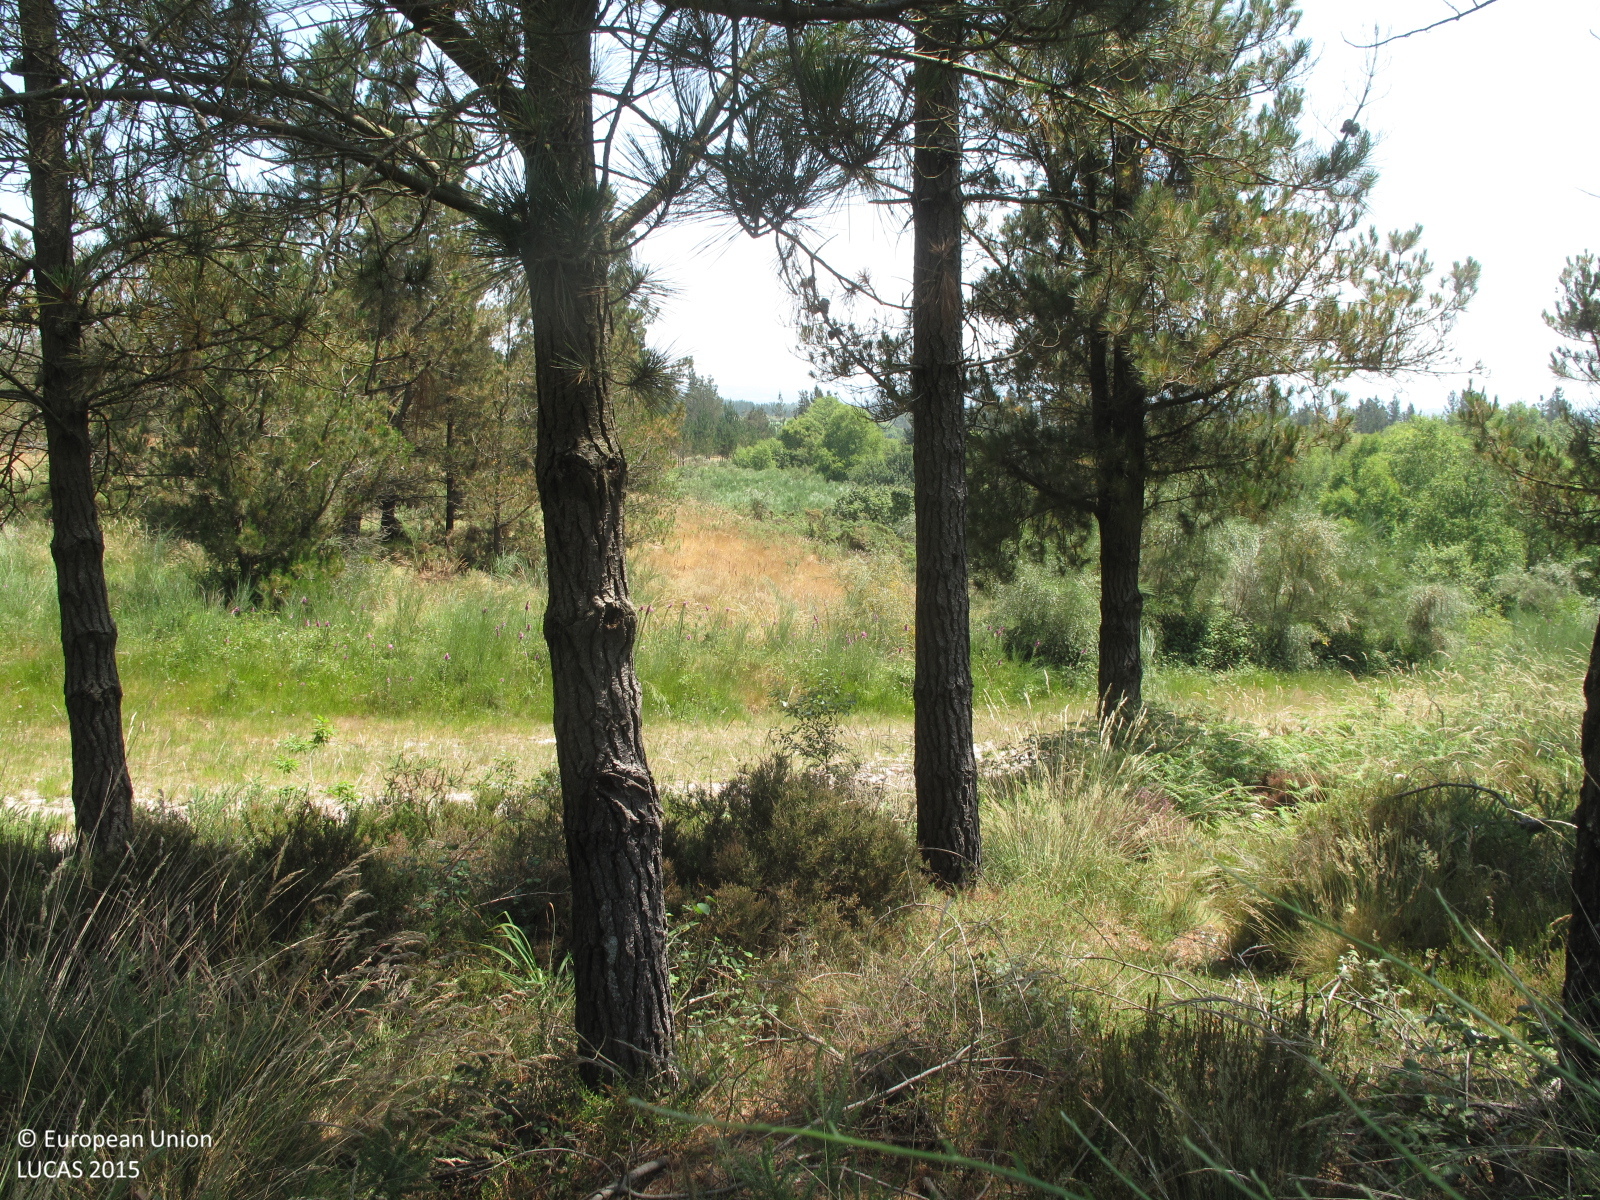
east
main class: Woodland
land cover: Pine dominated coniferous woodland
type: exotic forest
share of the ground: 25 - 50 %
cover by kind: herbaceous plants 40 %, coniferous forest trees 30 %, shrubs 30 %
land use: Forestry
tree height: > 5 m
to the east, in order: Pine dominated coniferous woodland; Tracks; Pine dominated coniferous woodland; Shrubland with sparse tree cover; Shrubland without tree cover; Pine dominated mixed woodland; Pine dominated coniferous woodland
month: June
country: ES
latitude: 43.2554
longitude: -7.9145
